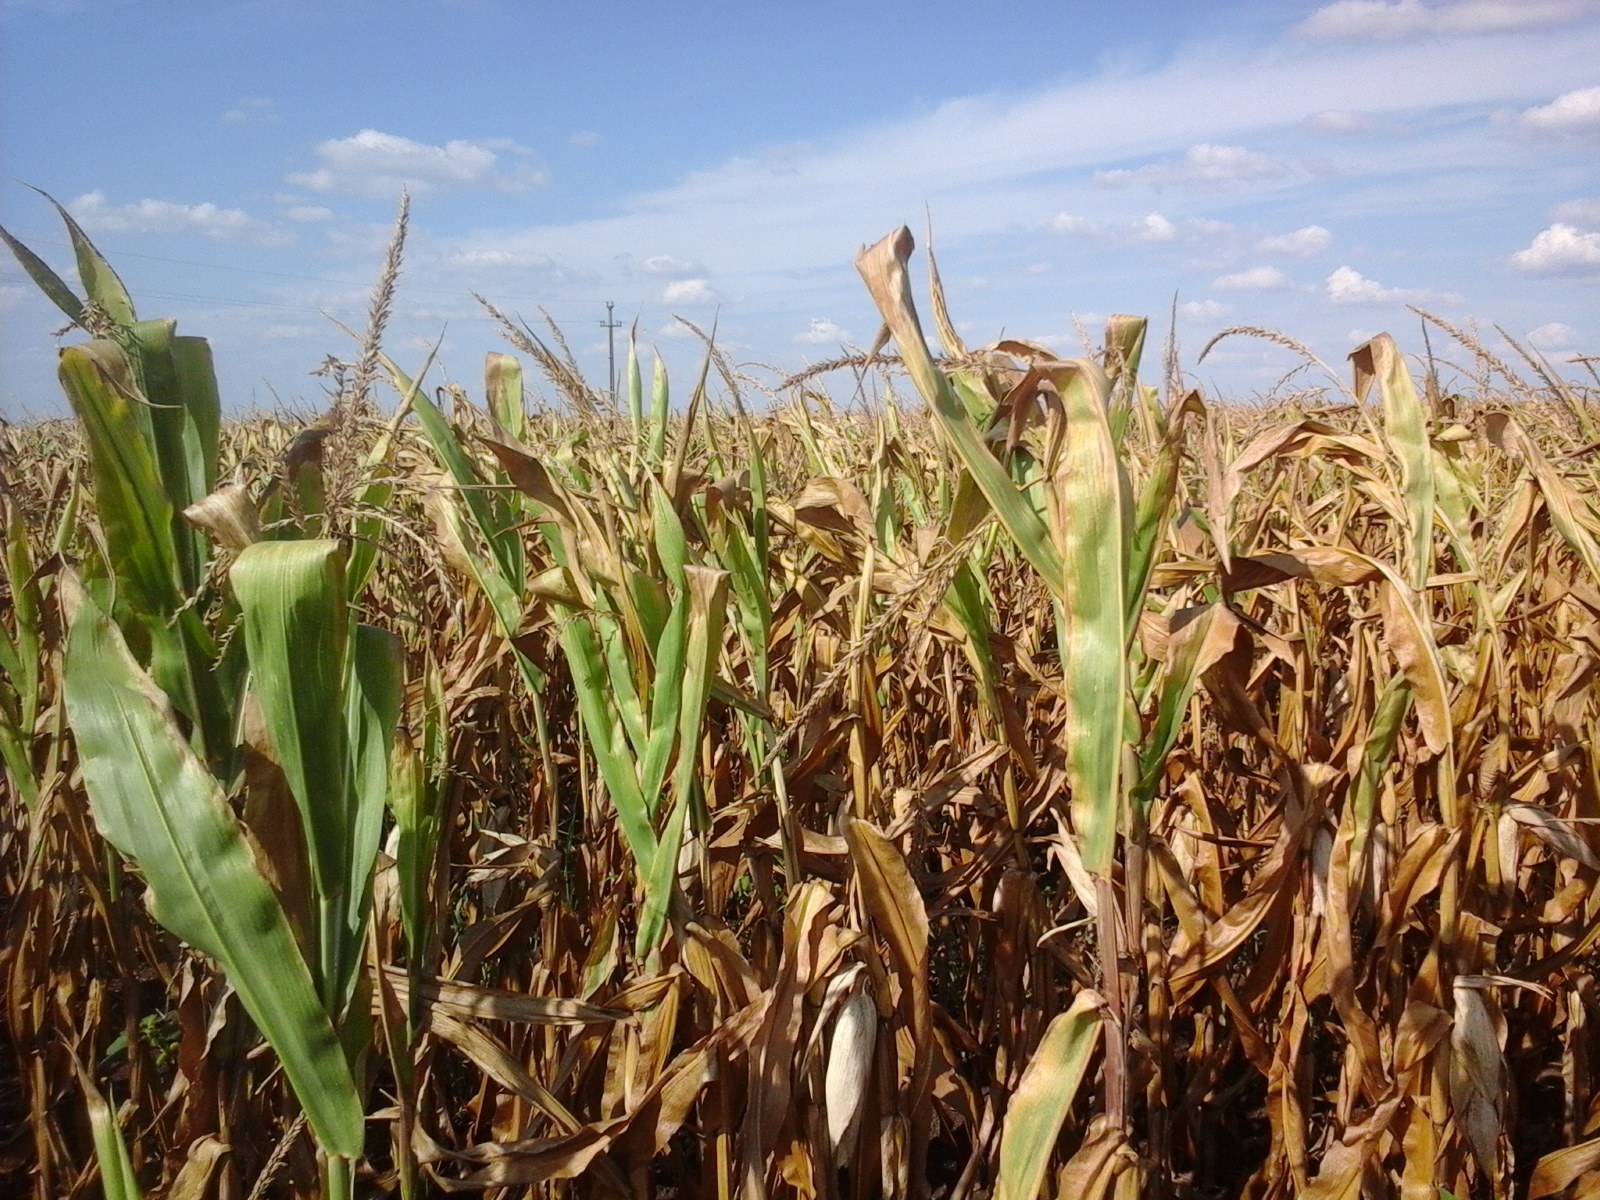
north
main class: Cropland
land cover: Maize
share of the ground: > 75 %
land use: Agriculture (excluding fallow land and kitchen gardens)
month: August
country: RO
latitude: 46.0958
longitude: 21.2994
